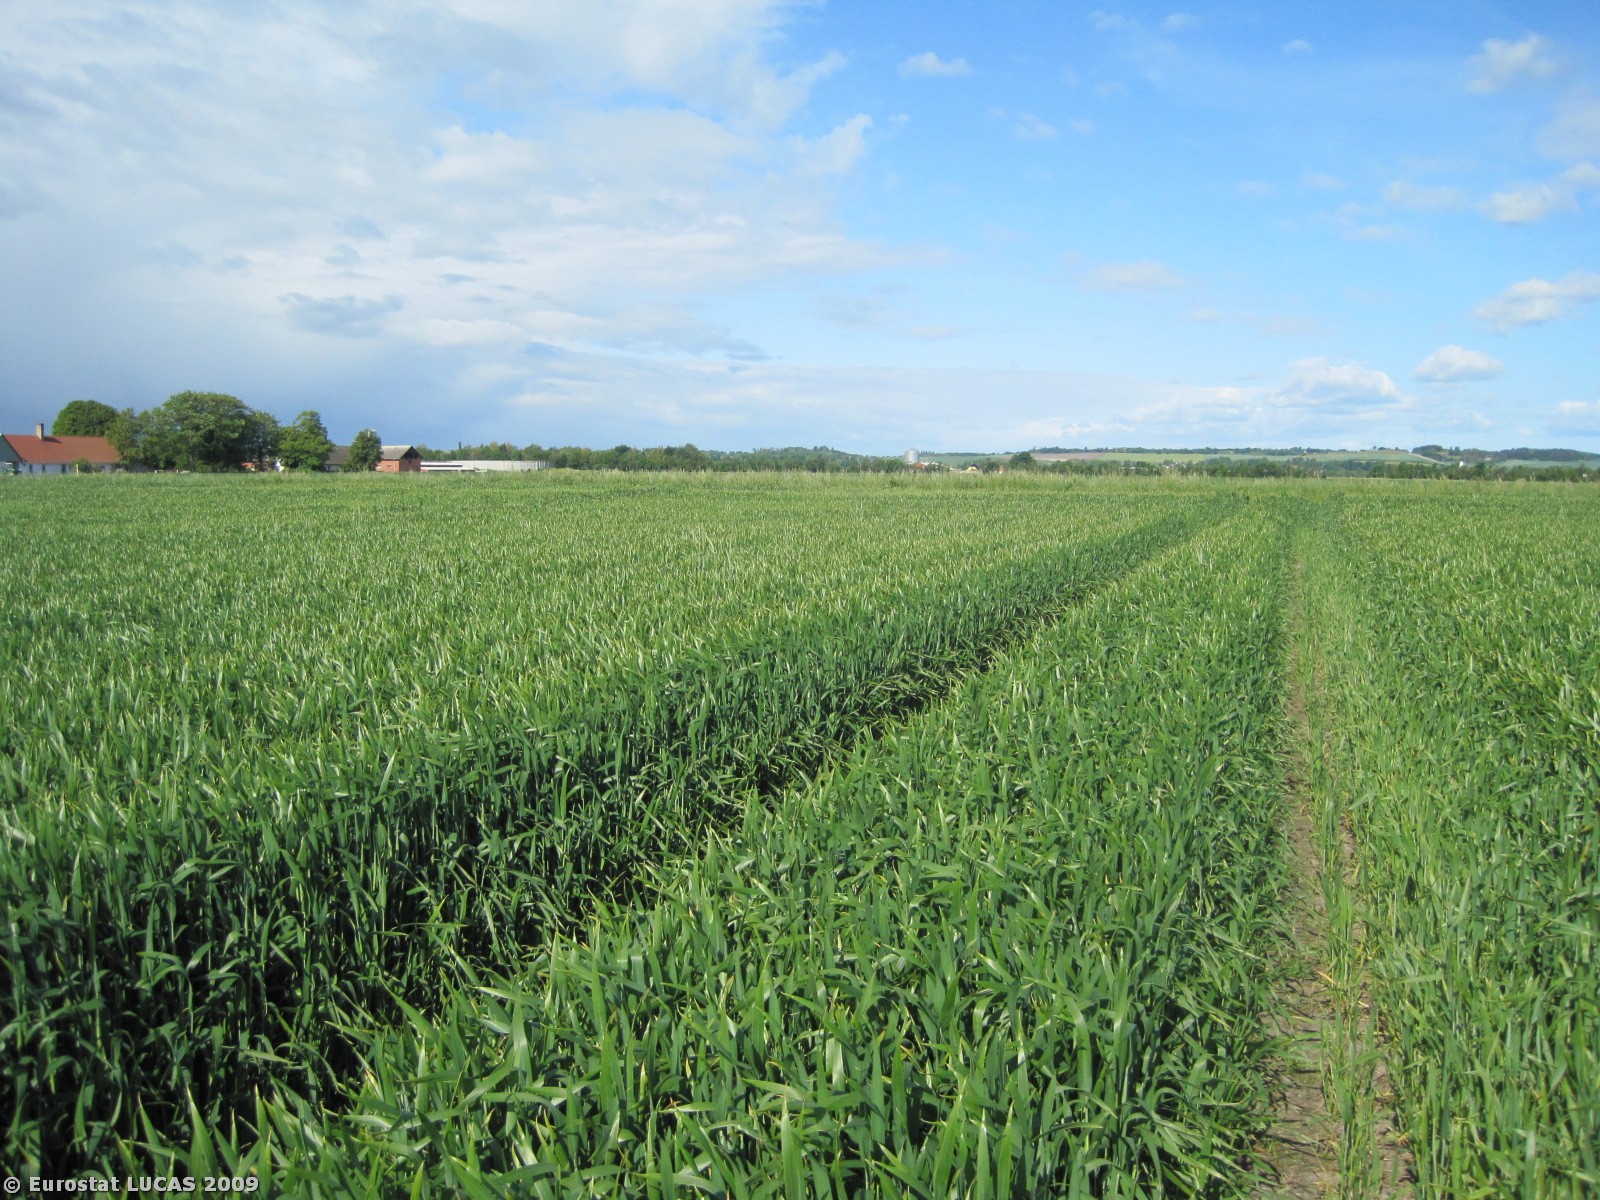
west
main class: Cropland
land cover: Common wheat
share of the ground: > 75 %
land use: Agriculture (excluding fallow land and kitchen gardens)
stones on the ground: < 10 %
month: June
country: DK
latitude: 56.9786
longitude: 10.1479
